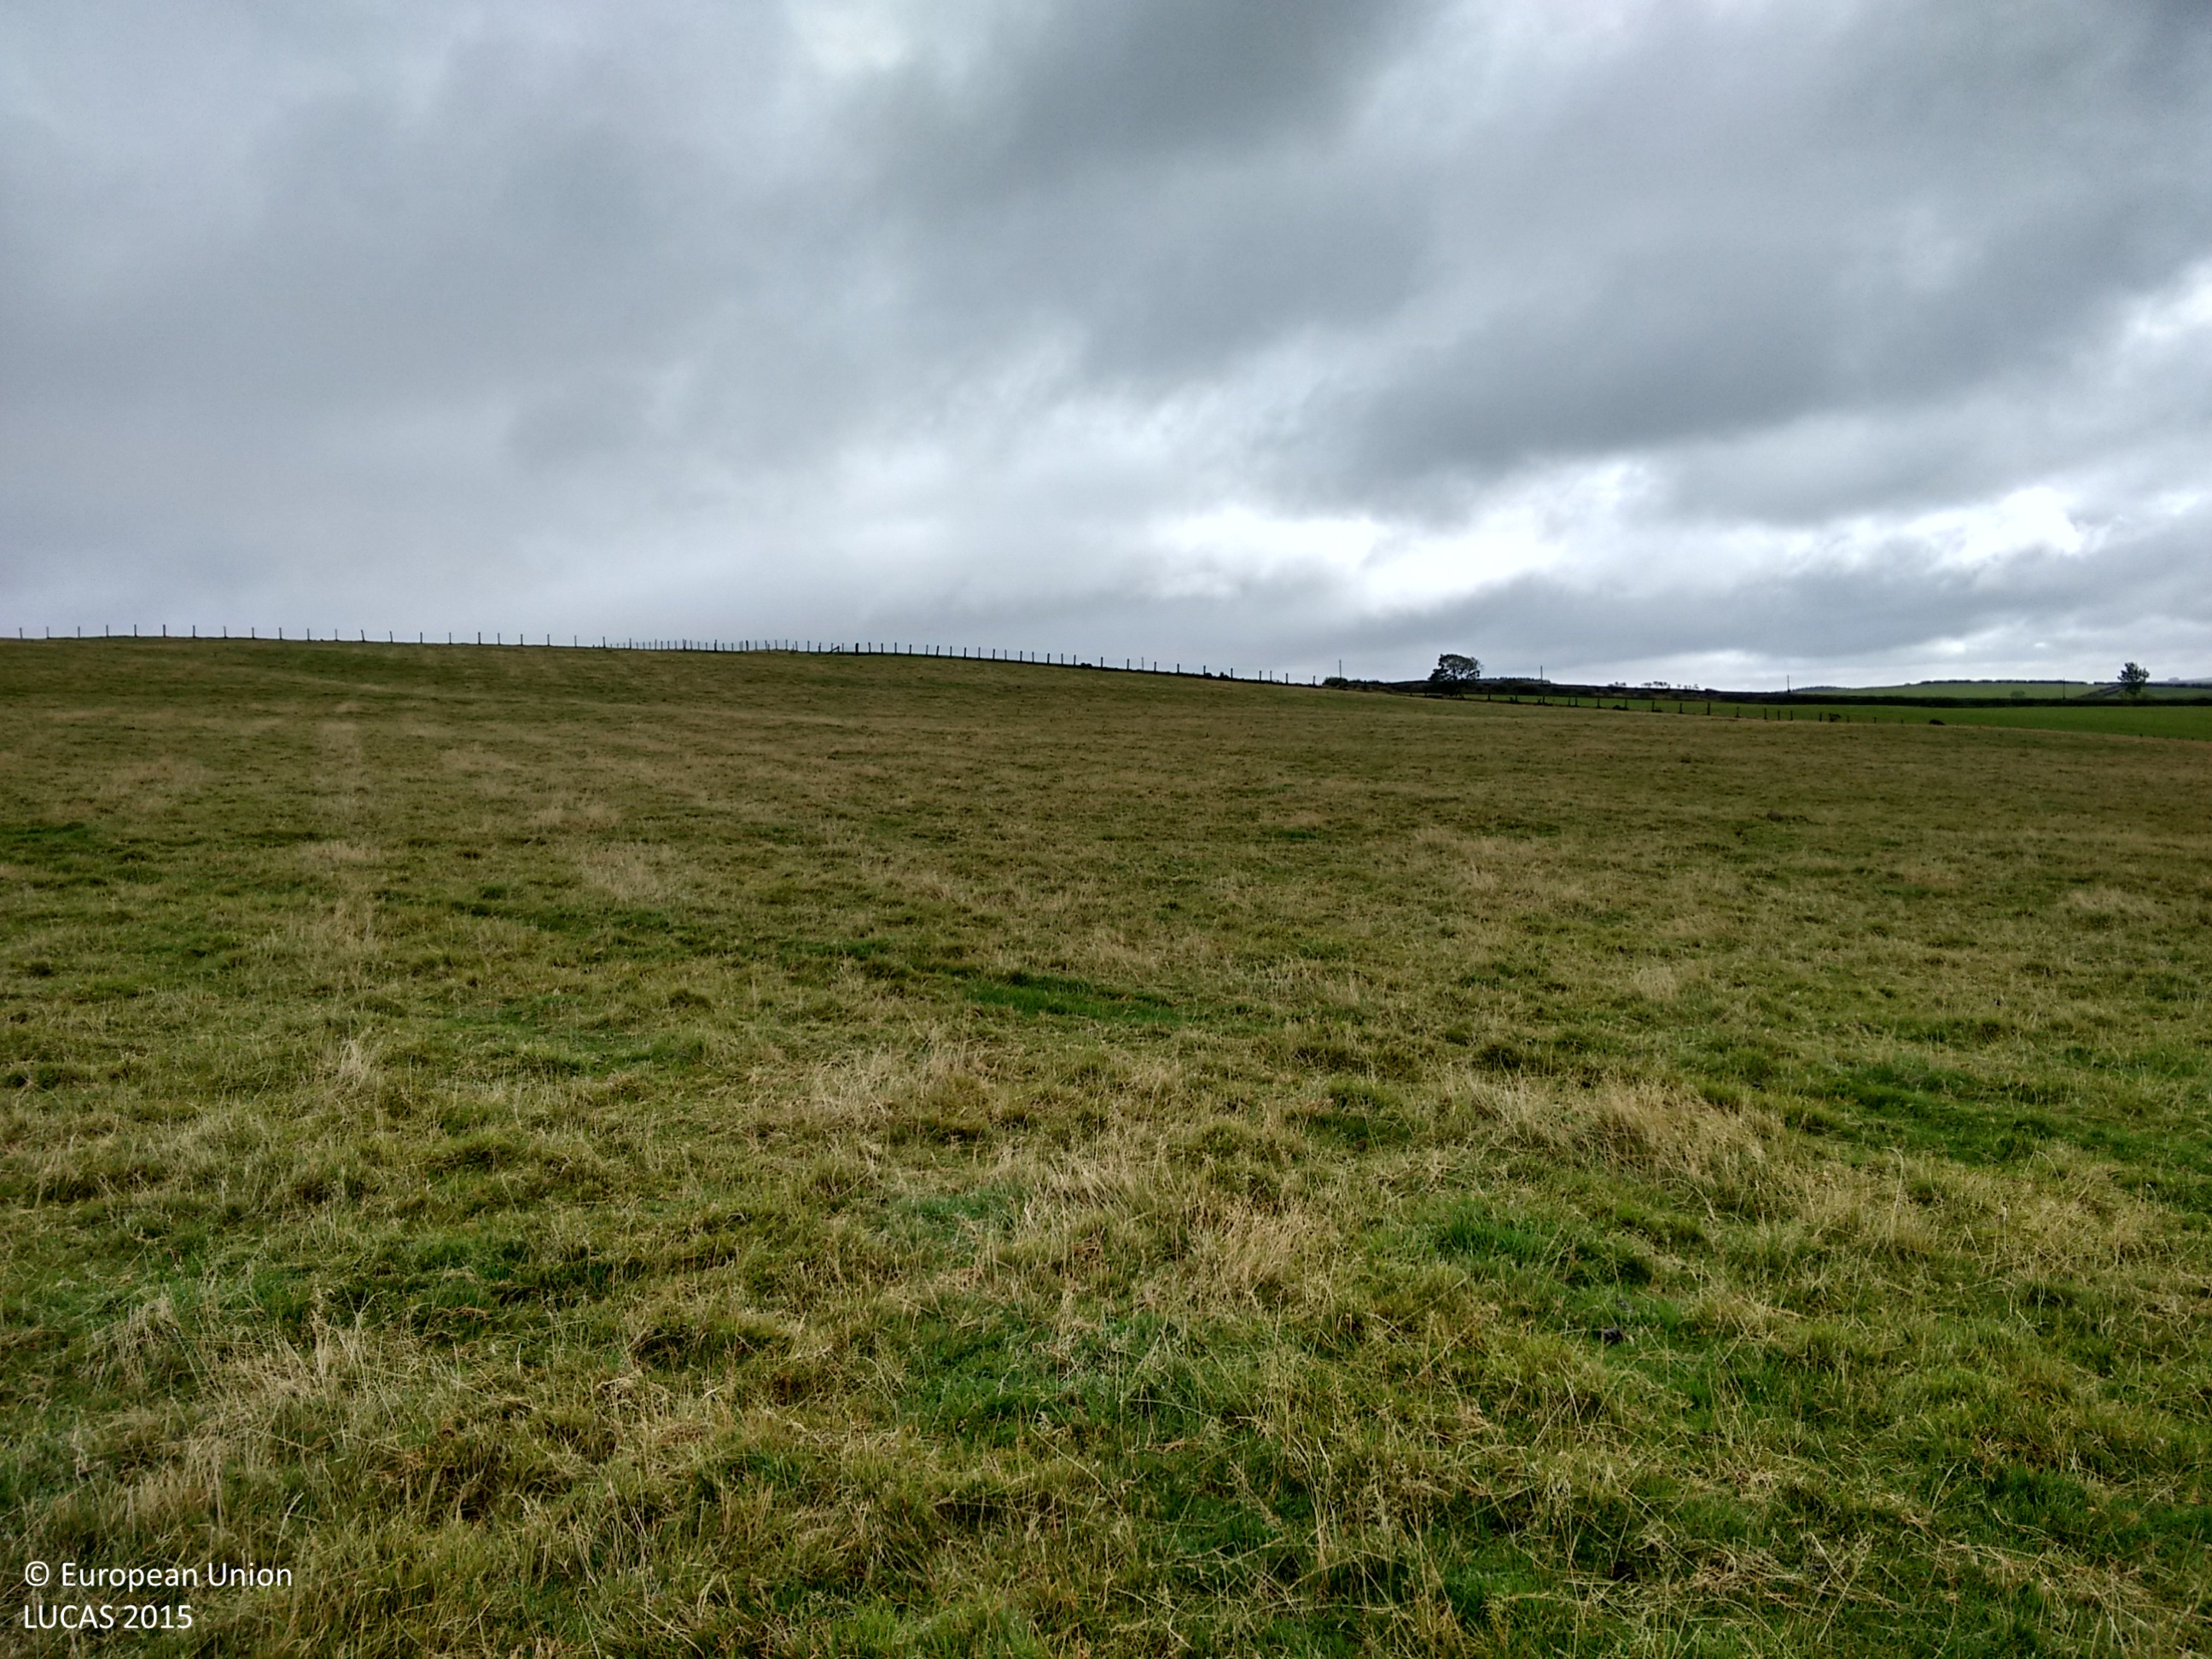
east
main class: Grassland
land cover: Grassland without tree/shrub cover
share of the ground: > 75 %
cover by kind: herbaceous plants 100 %
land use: Agriculture (excluding fallow land and kitchen gardens)
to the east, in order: Grassland without tree/shrub cover; Fences; Grassland without tree/shrub cover
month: October
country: GB
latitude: 52.4365
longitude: -3.2146
